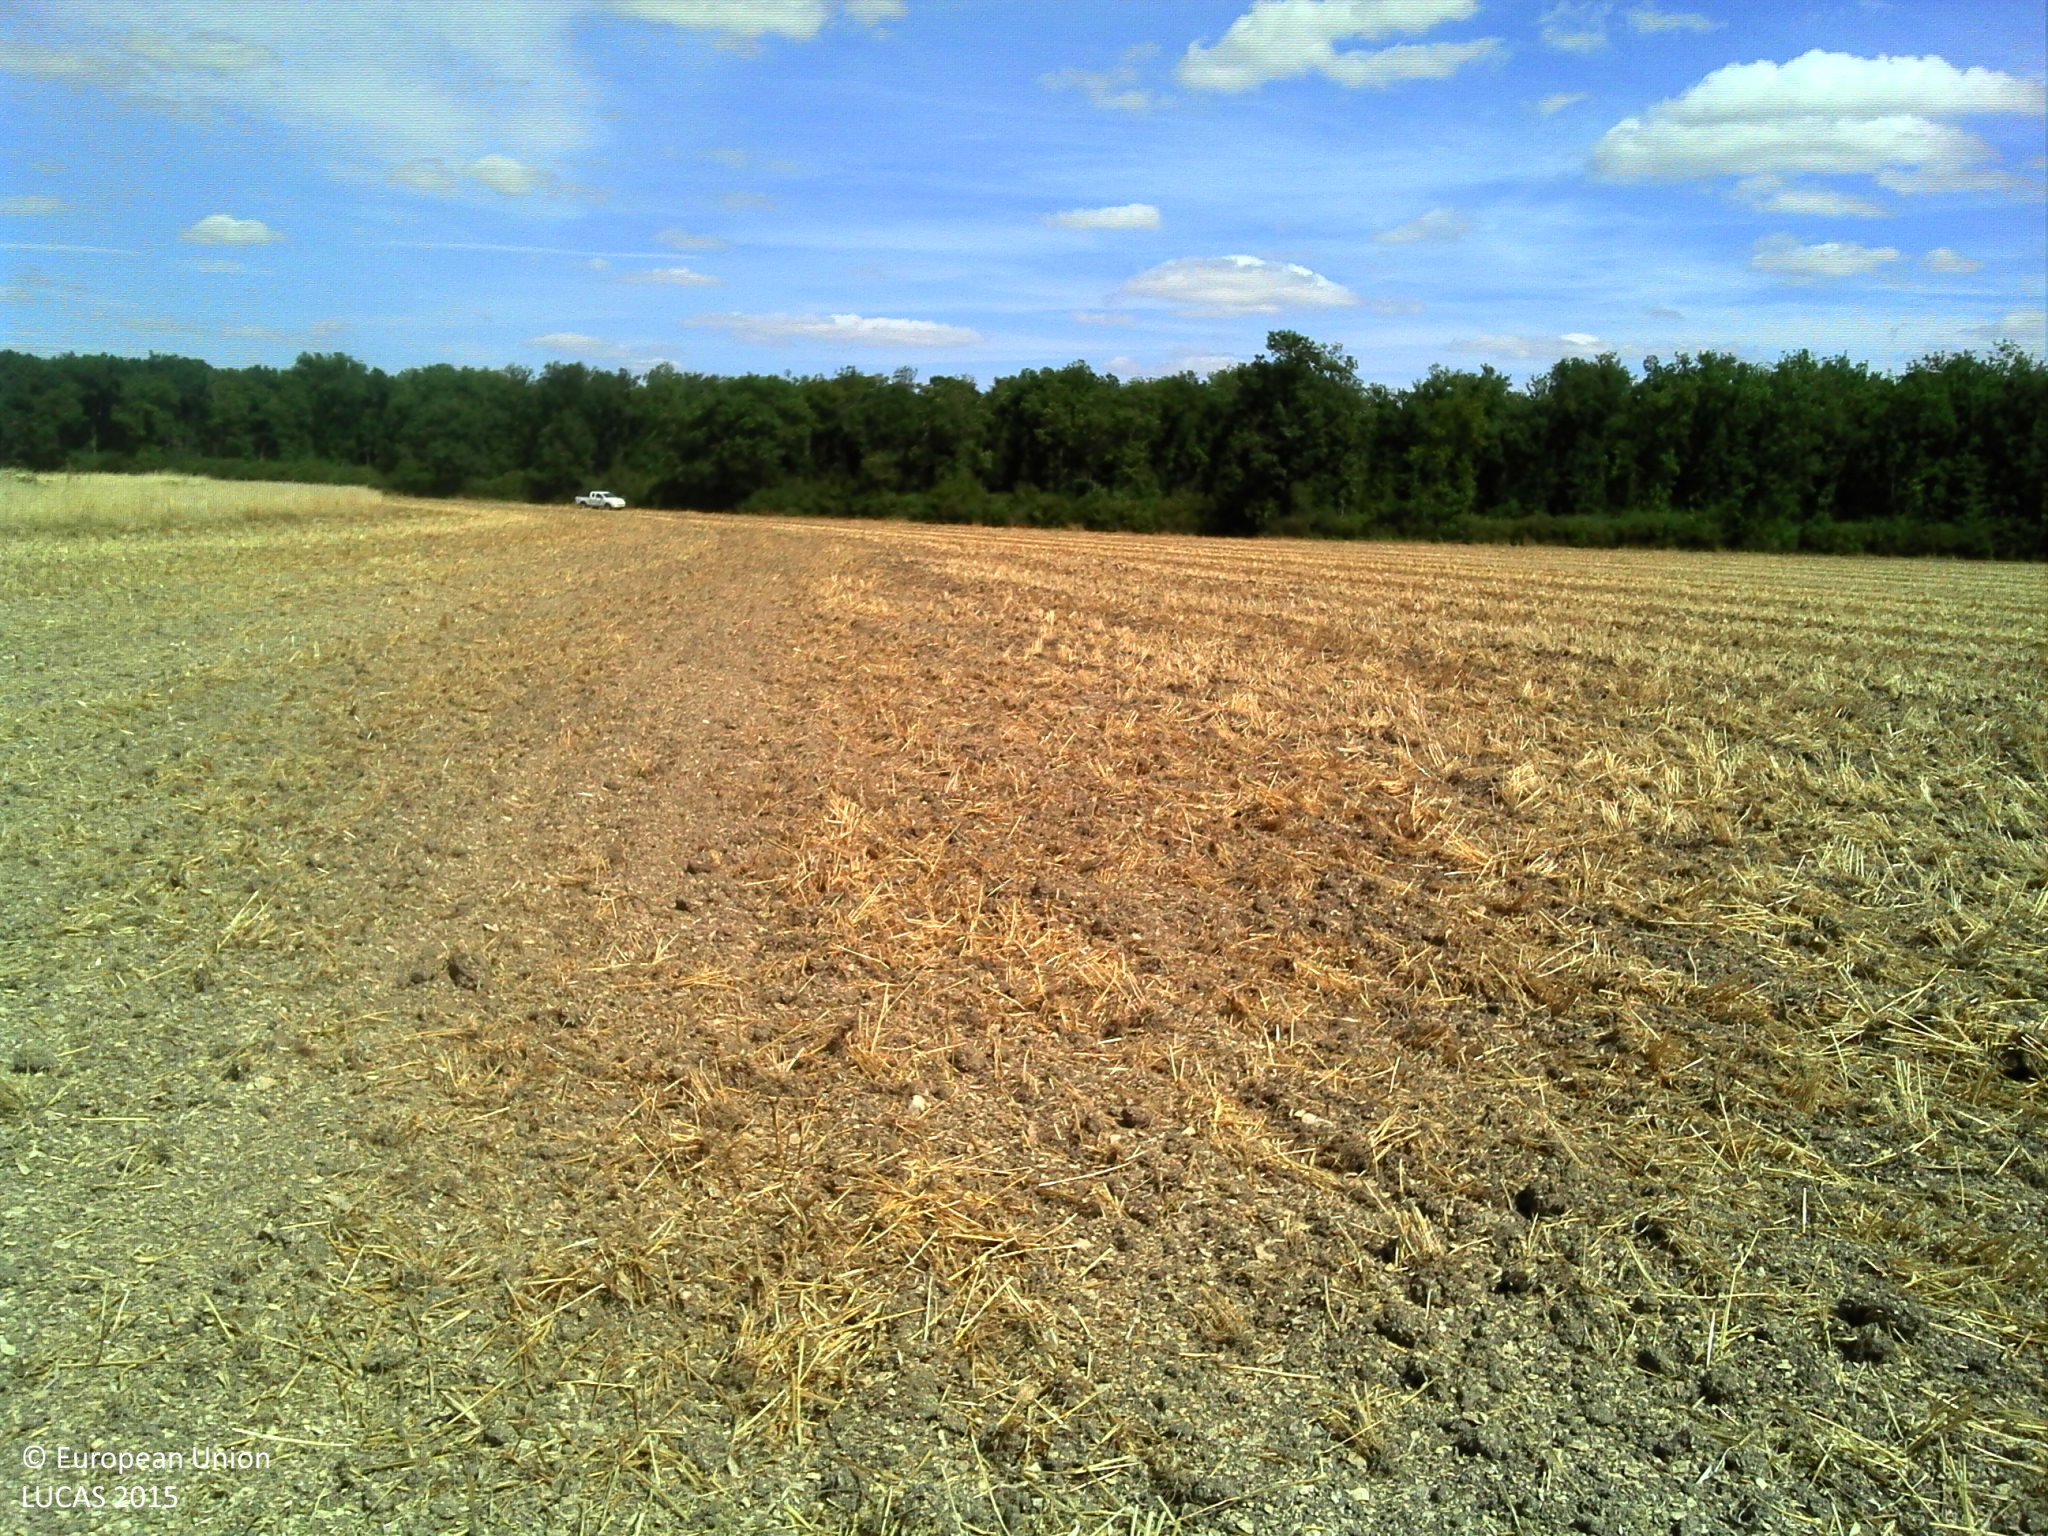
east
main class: Cropland
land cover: Barley
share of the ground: > 75 %
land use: Agriculture (excluding fallow land and kitchen gardens)
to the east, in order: Barley; Tracks; Broadleaved woodland
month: July
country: FR
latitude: 47.0183
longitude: 2.1112
